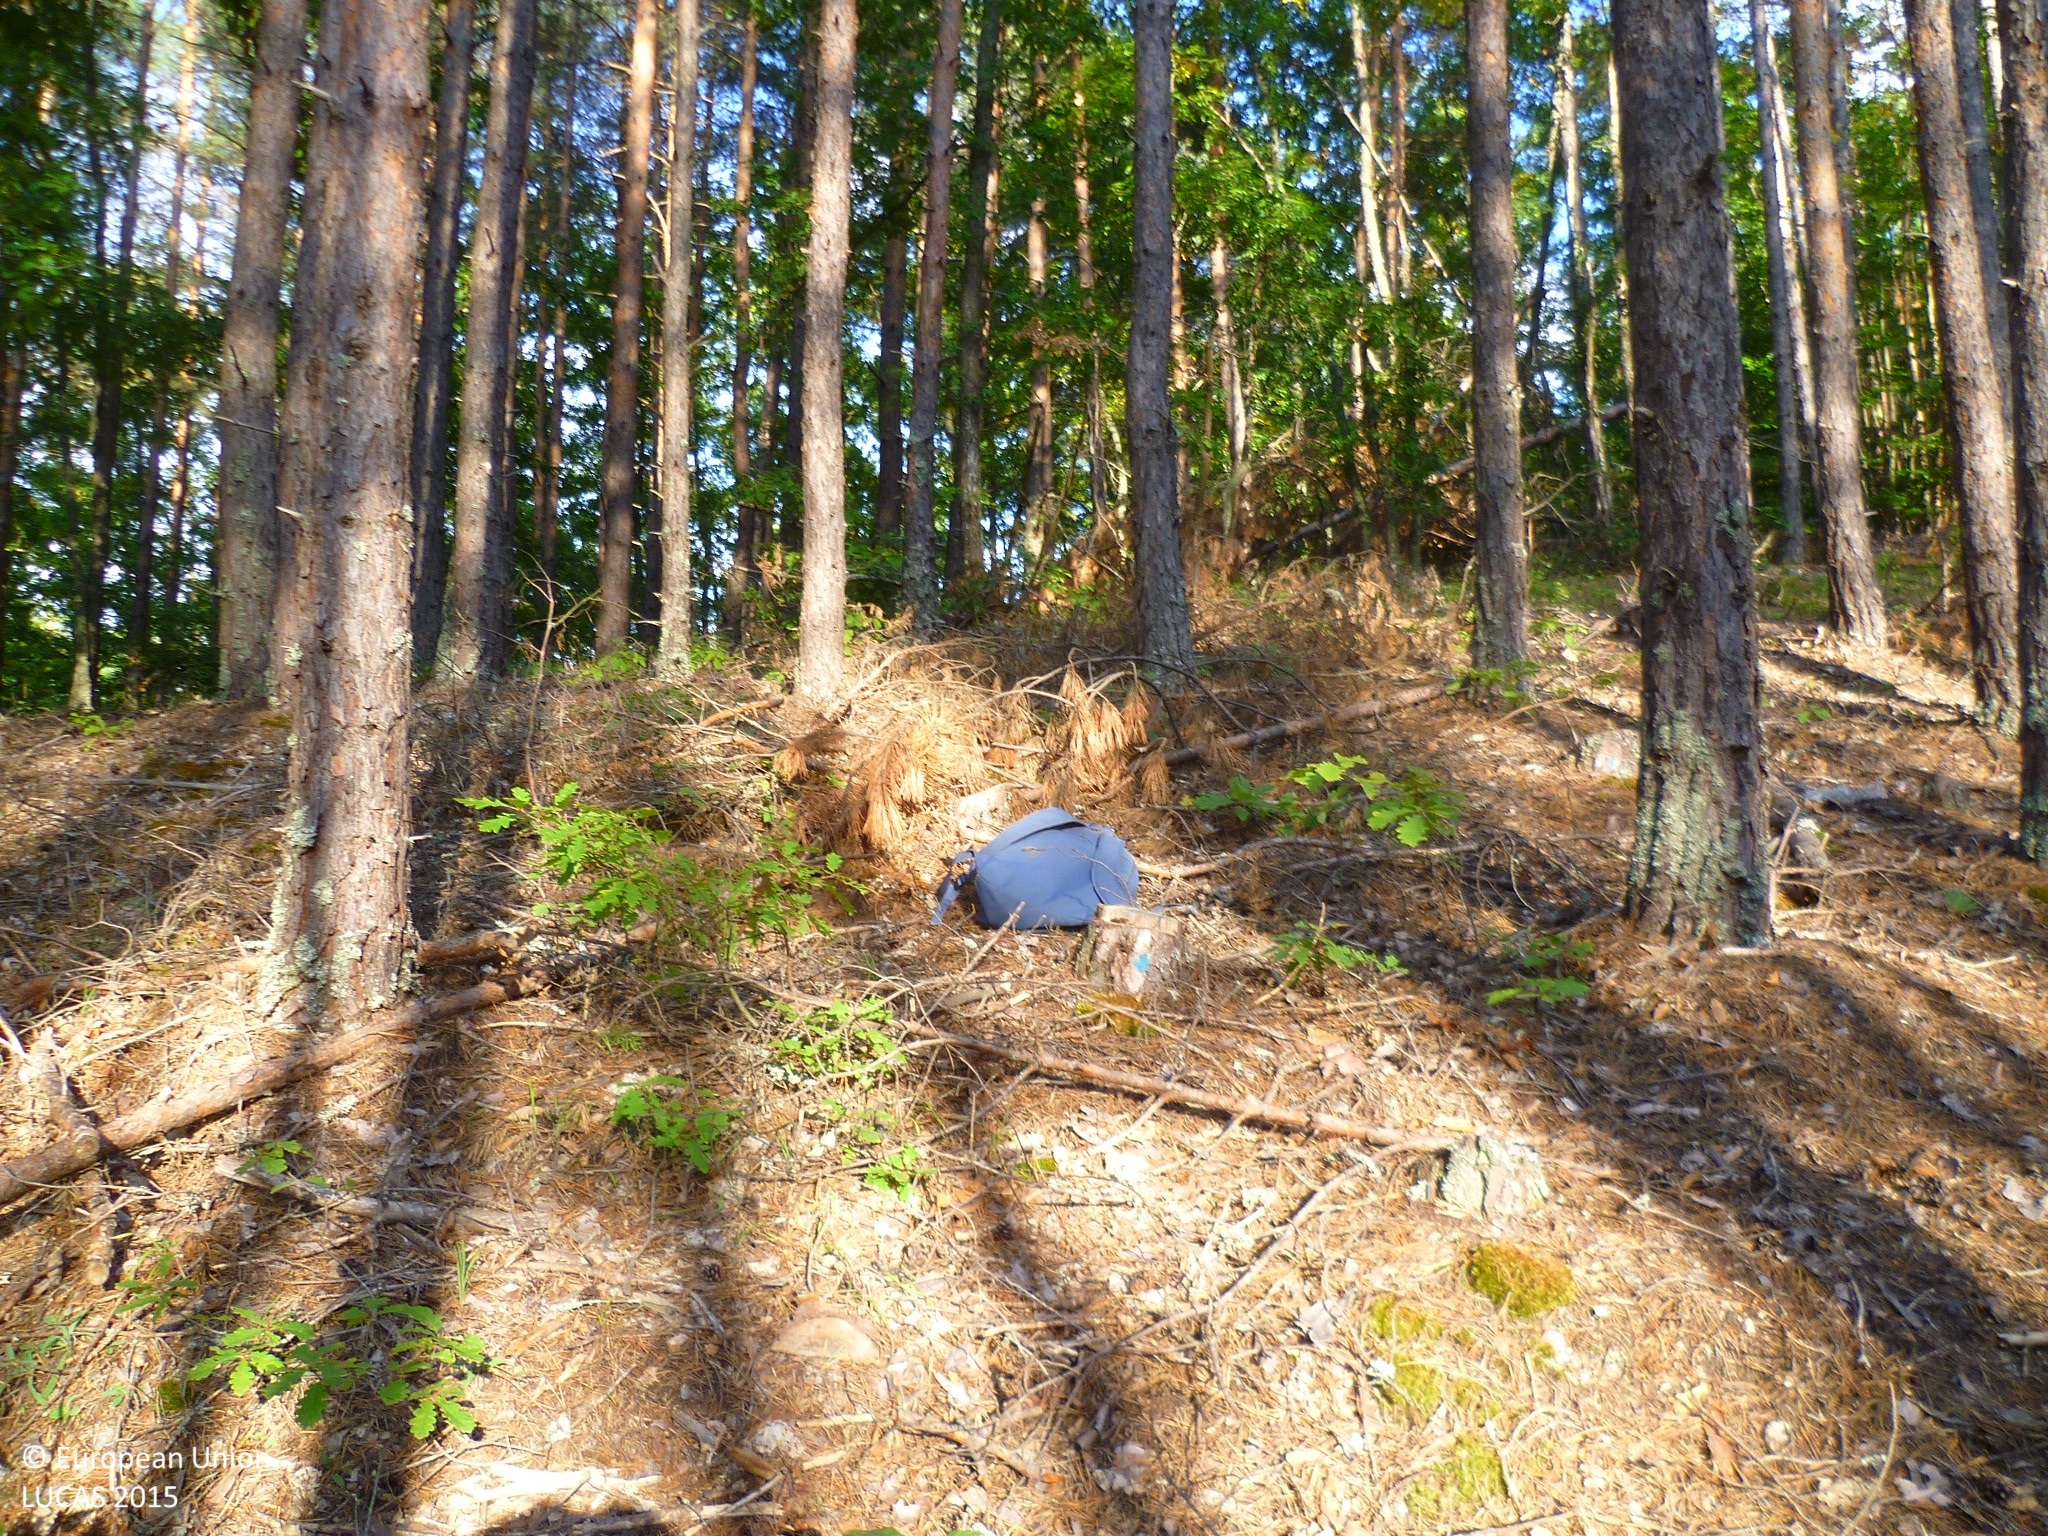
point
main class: Woodland
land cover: Pine dominated mixed woodland
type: hemiboreal forest and nemoral coniferous forest and mixed broadleaved-coniferous forest
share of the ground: > 75 %
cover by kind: coniferous forest trees 60 %, broadleaved forest trees 20 %, unconsolidated bare surface 15 %, herbaceous plants 5 %
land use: Forestry
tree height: > 5 m
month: October
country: BG
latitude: 42.7848
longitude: 22.6783
